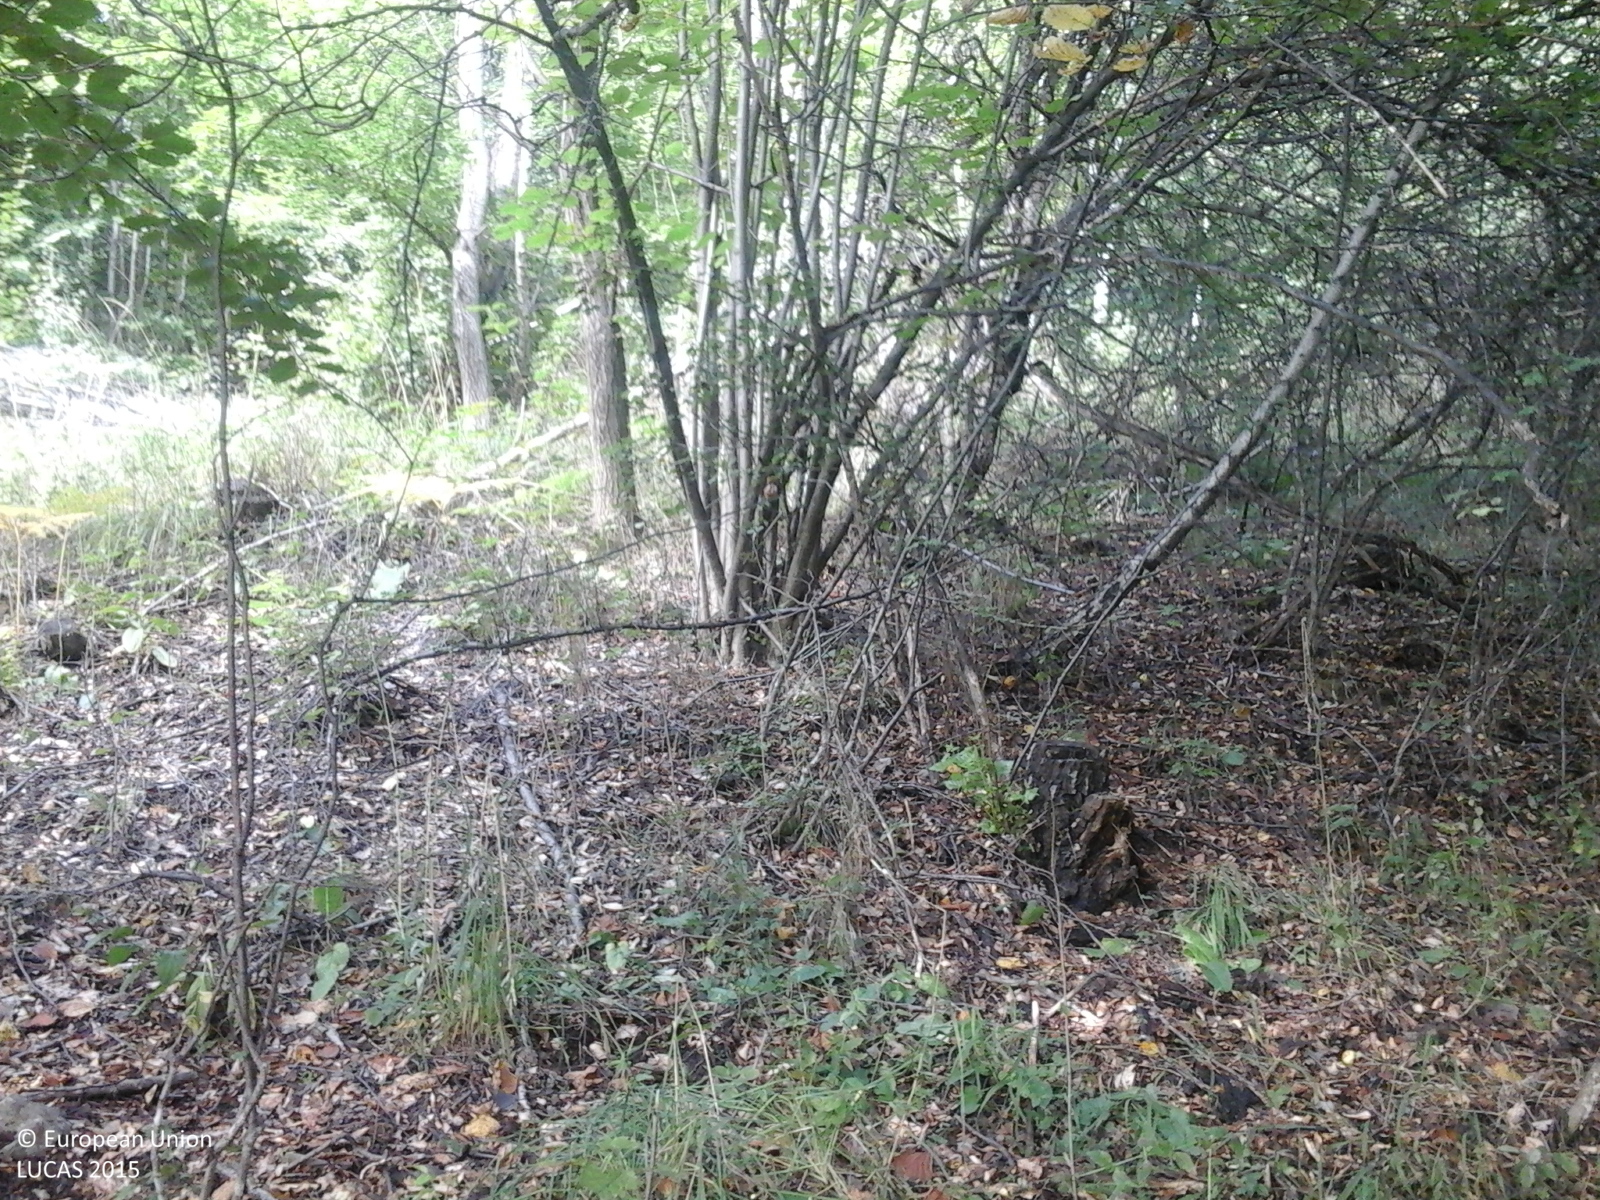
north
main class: Woodland
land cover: Broadleaved woodland
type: mesophytic deciduous forest
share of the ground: > 75 %
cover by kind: broadleaved forest trees 100 %
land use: Forestry
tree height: > 5 m
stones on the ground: > 50 %
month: October
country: RO
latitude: 46.6632
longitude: 23.1717
